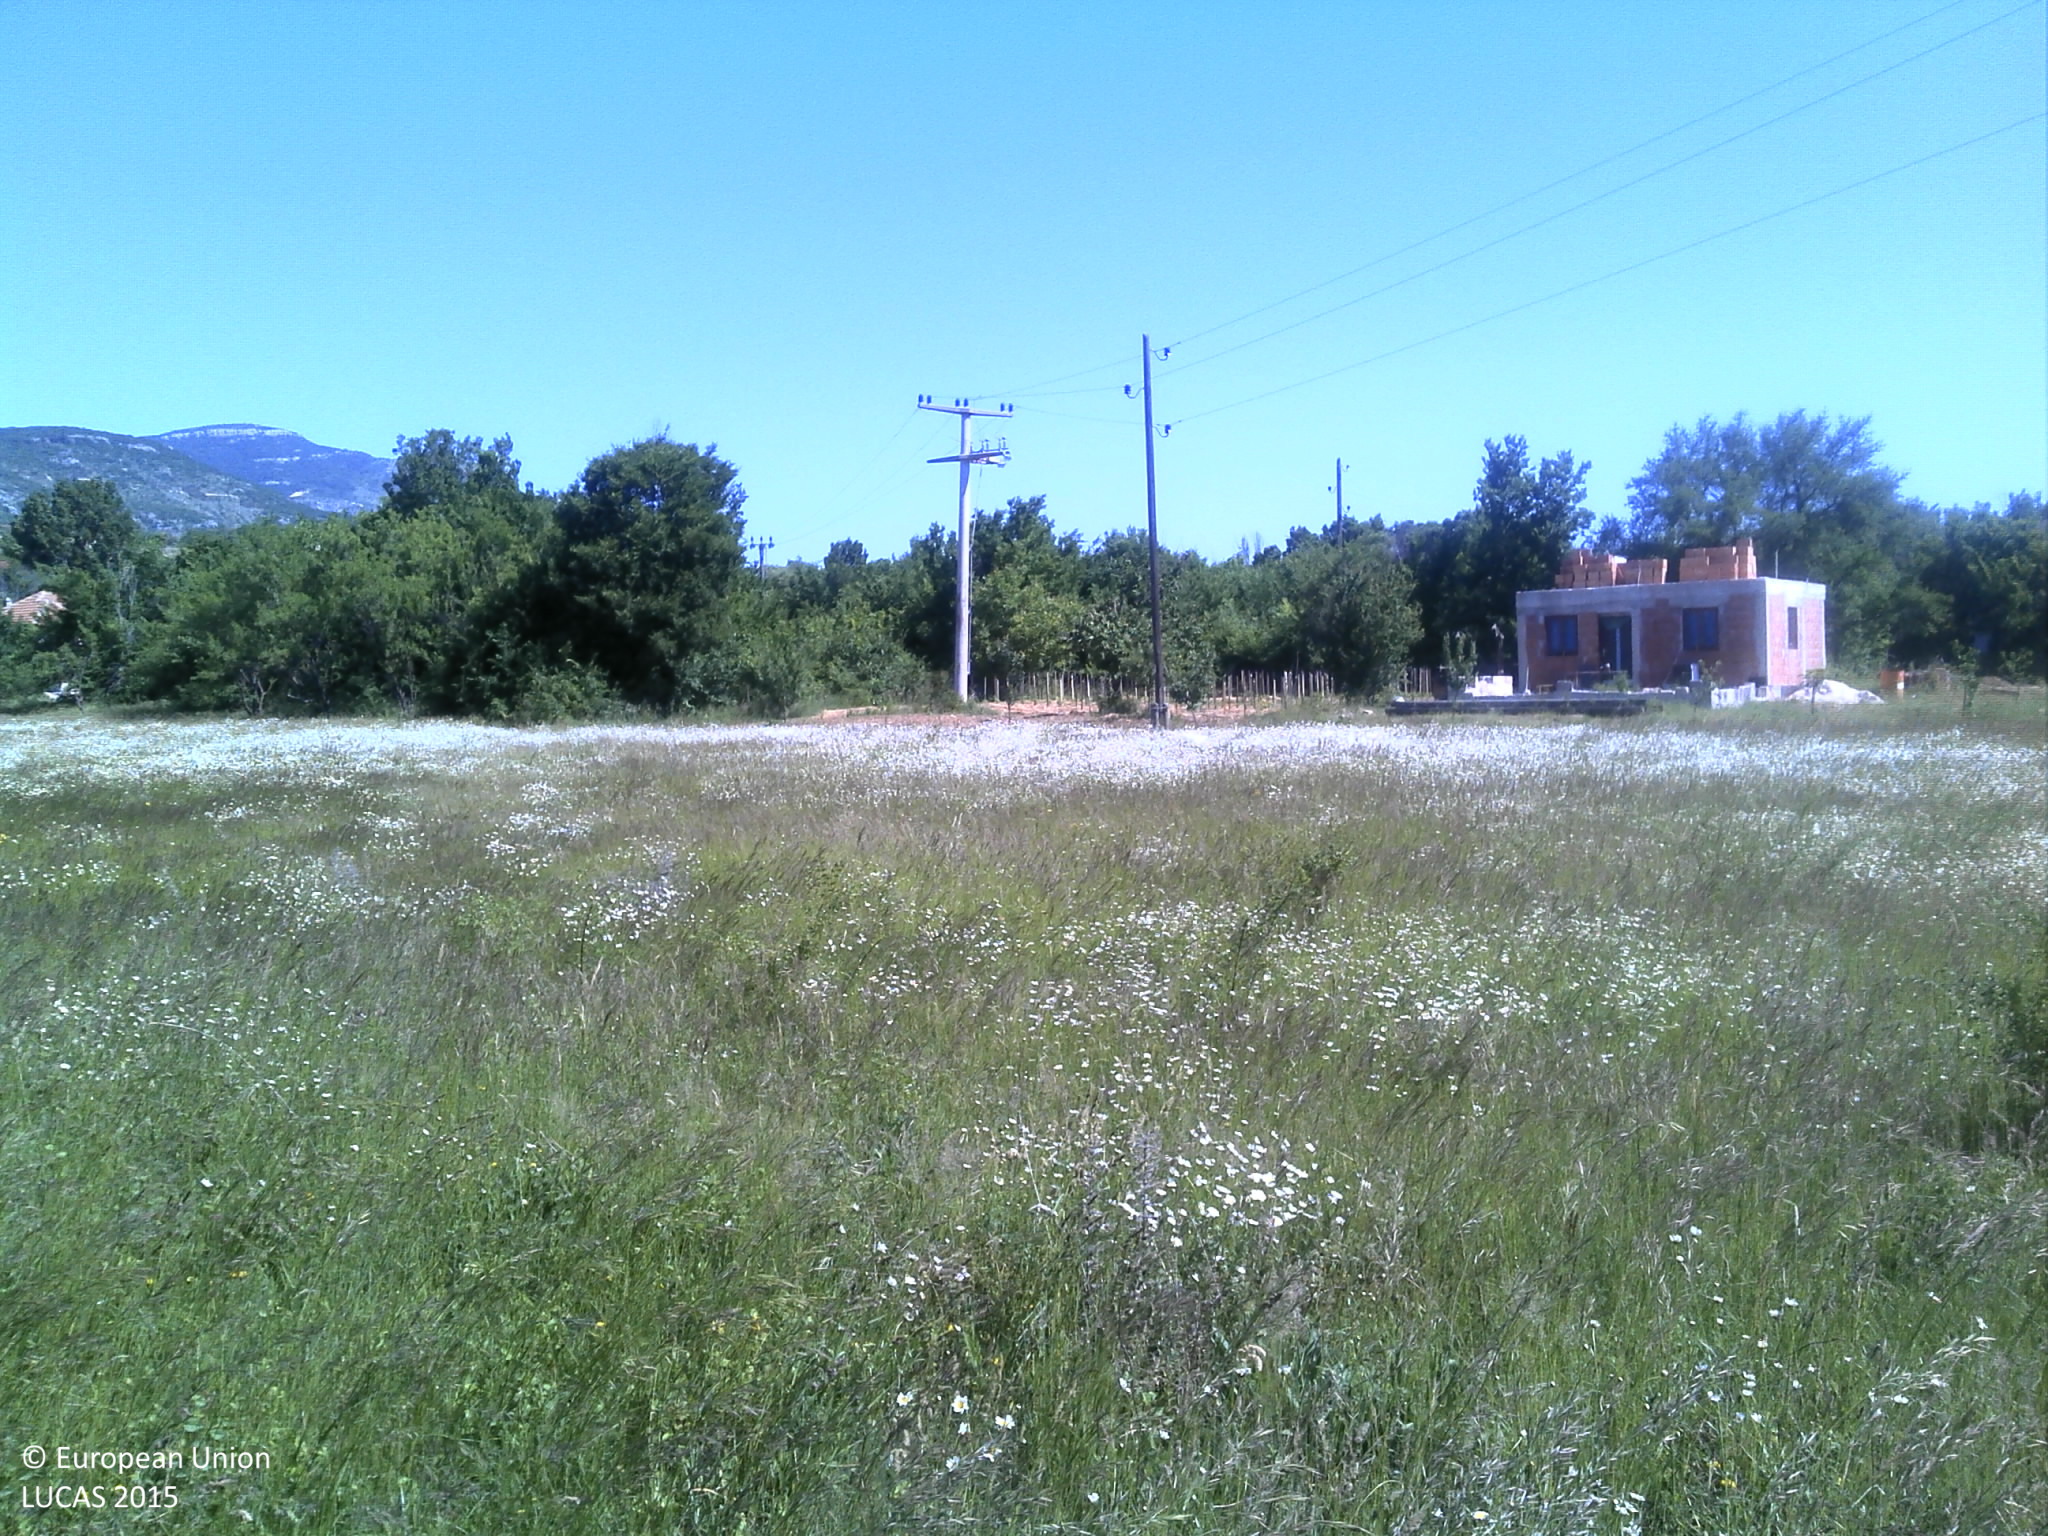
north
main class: Shrubland
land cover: Shrubland with sparse tree cover
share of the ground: 25 - 50 %
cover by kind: herbaceous plants 65 %, shrubs 30 %, broadleaved forest trees 5 %
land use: Semi-natural and natural areas not in use
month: May
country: HR
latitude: 43.8756
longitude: 16.2019
